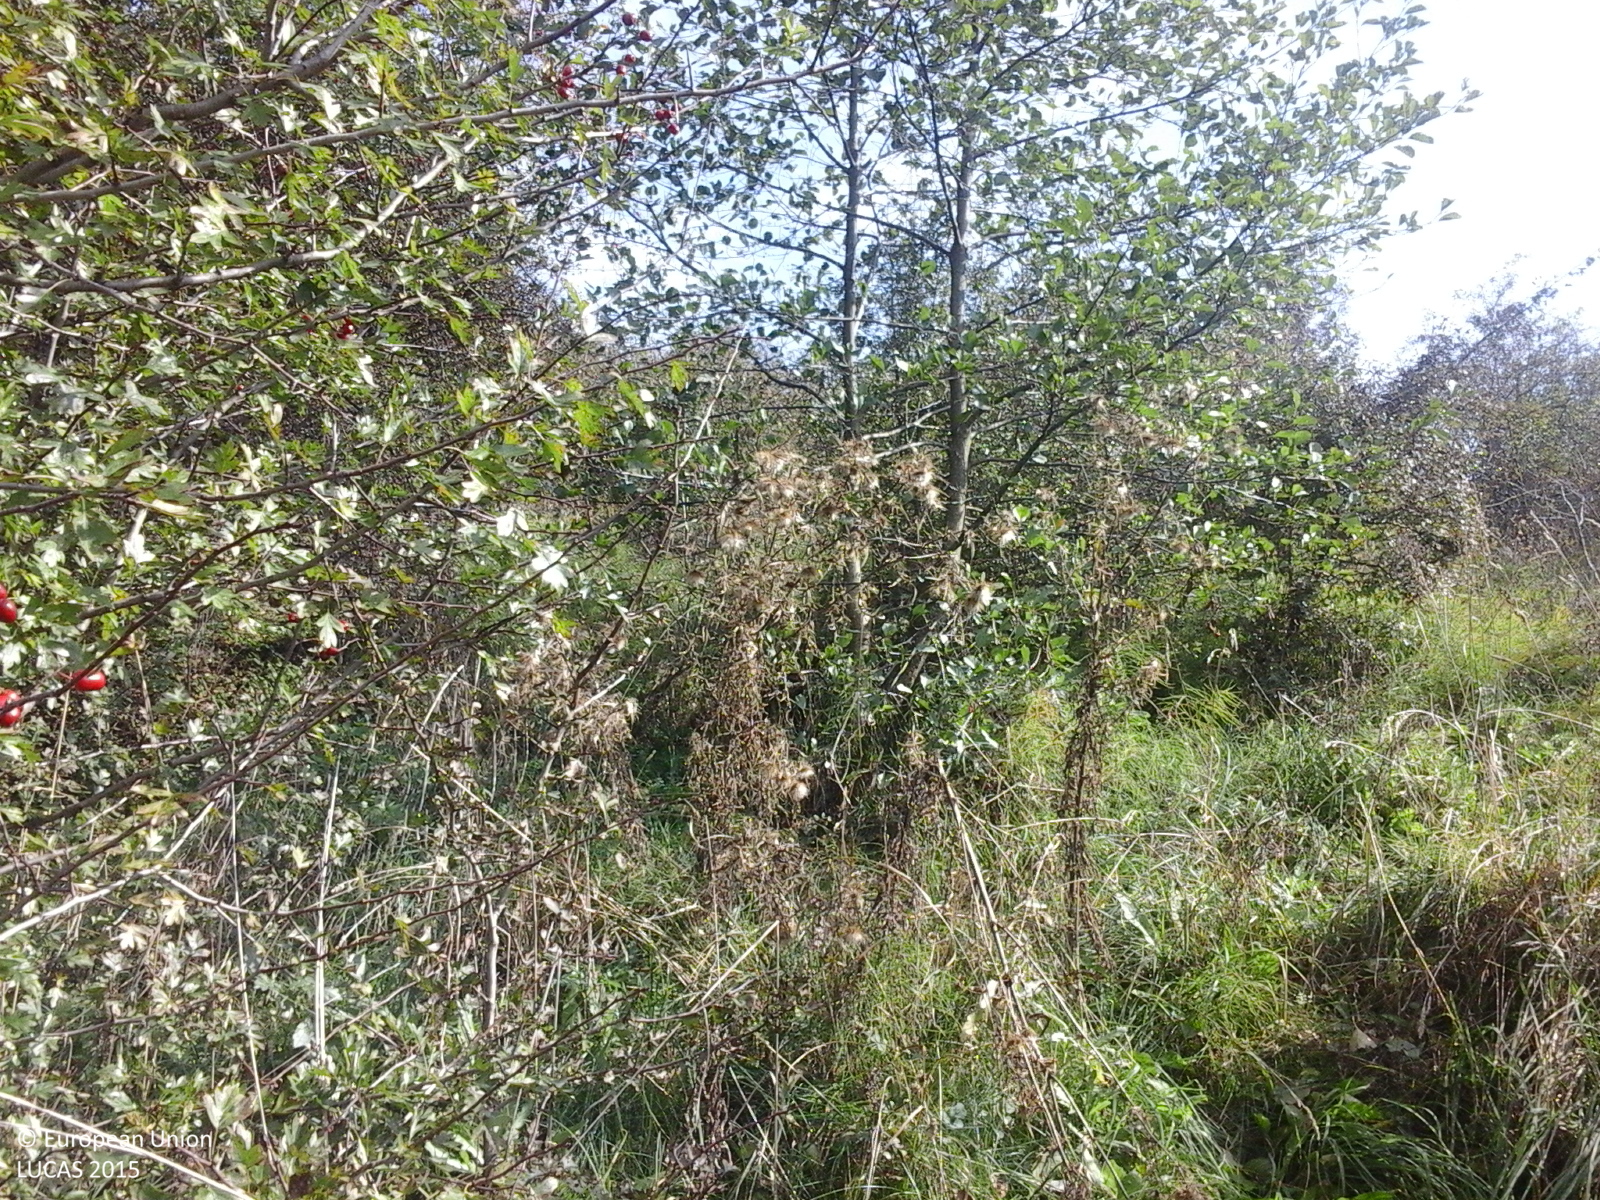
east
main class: Grassland
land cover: Grassland with sparse tree/shrub cover
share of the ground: > 75 %
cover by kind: herbaceous plants 85 %, shrubs 10 %, broadleaved forest trees 5 %
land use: Fallow land
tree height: > 5 m
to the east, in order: Grassland with sparse tree/shrub cover; Broadleaved woodland; Grassland with sparse tree/shrub cover; Broadleaved woodland
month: October
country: RO
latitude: 46.4387
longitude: 25.1330
